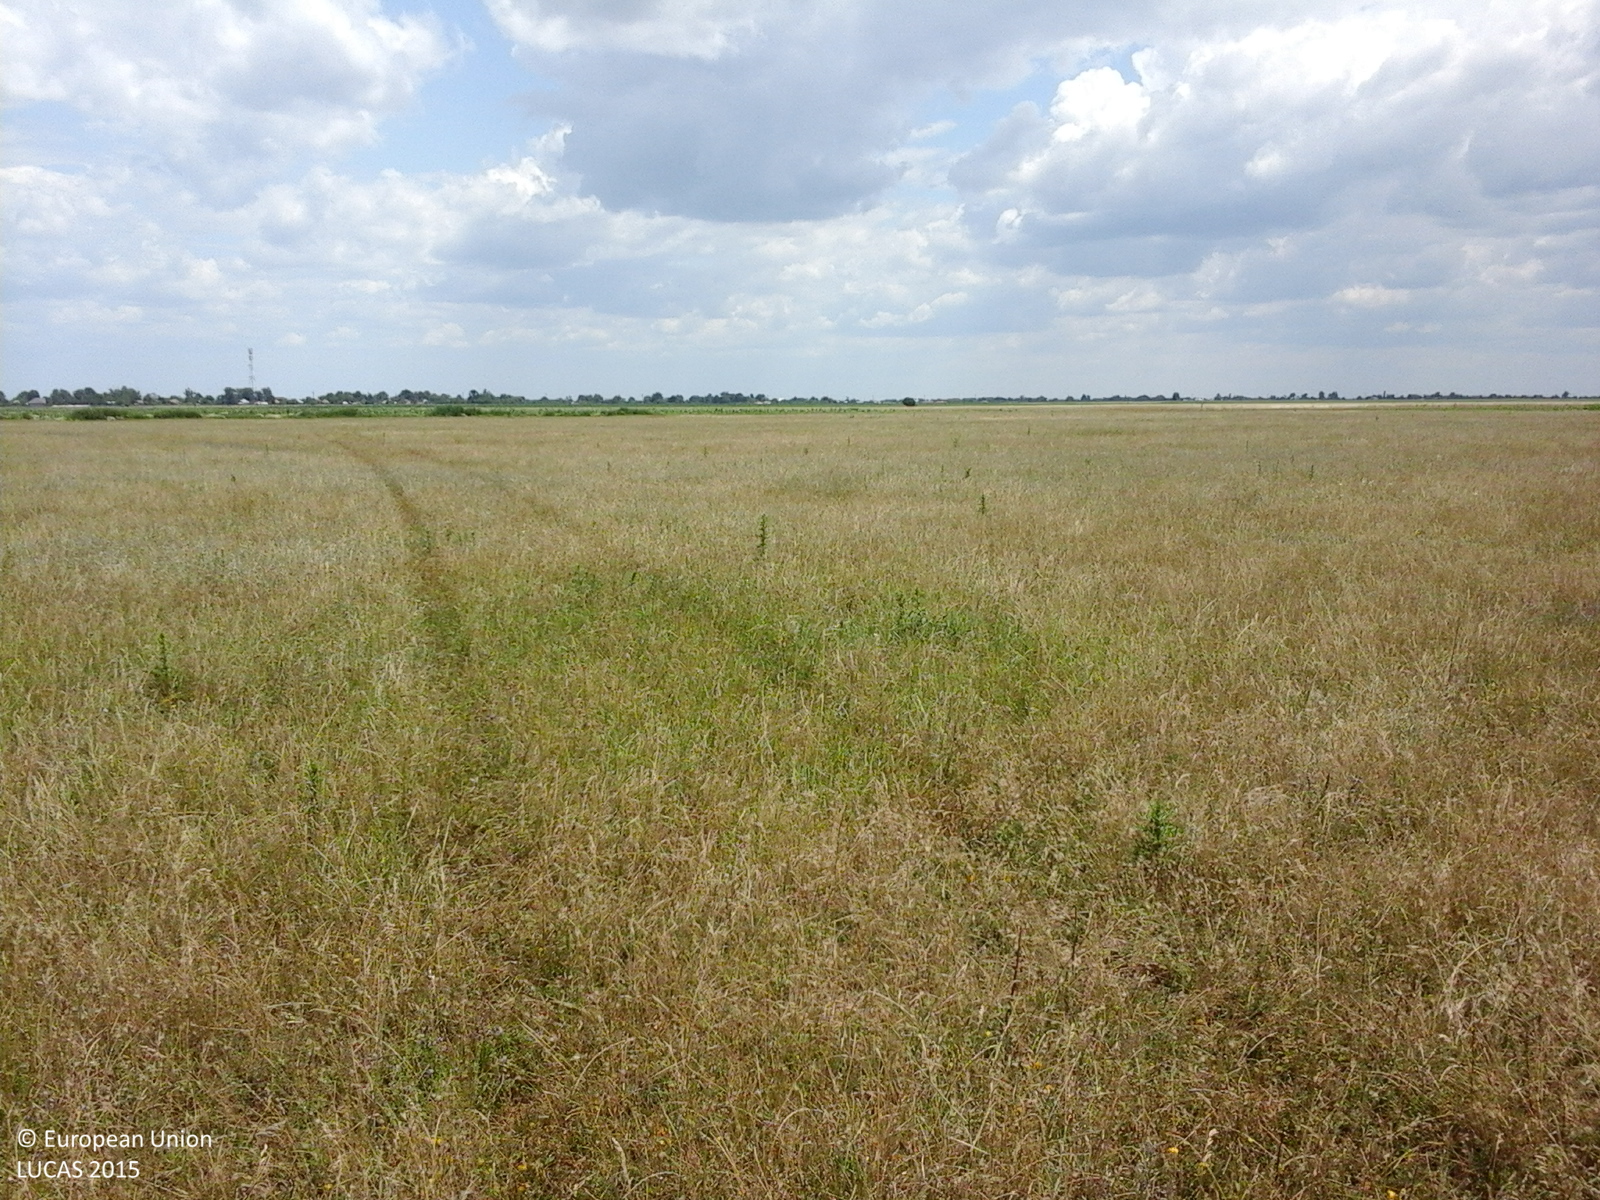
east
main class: Grassland
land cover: Grassland without tree/shrub cover
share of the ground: > 75 %
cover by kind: herbaceous plants 100 %
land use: Agriculture (excluding fallow land and kitchen gardens)
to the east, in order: Grassland without tree/shrub cover; Tracks; Grass margins; Maize
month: July
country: RO
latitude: 44.2613
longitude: 24.7415
